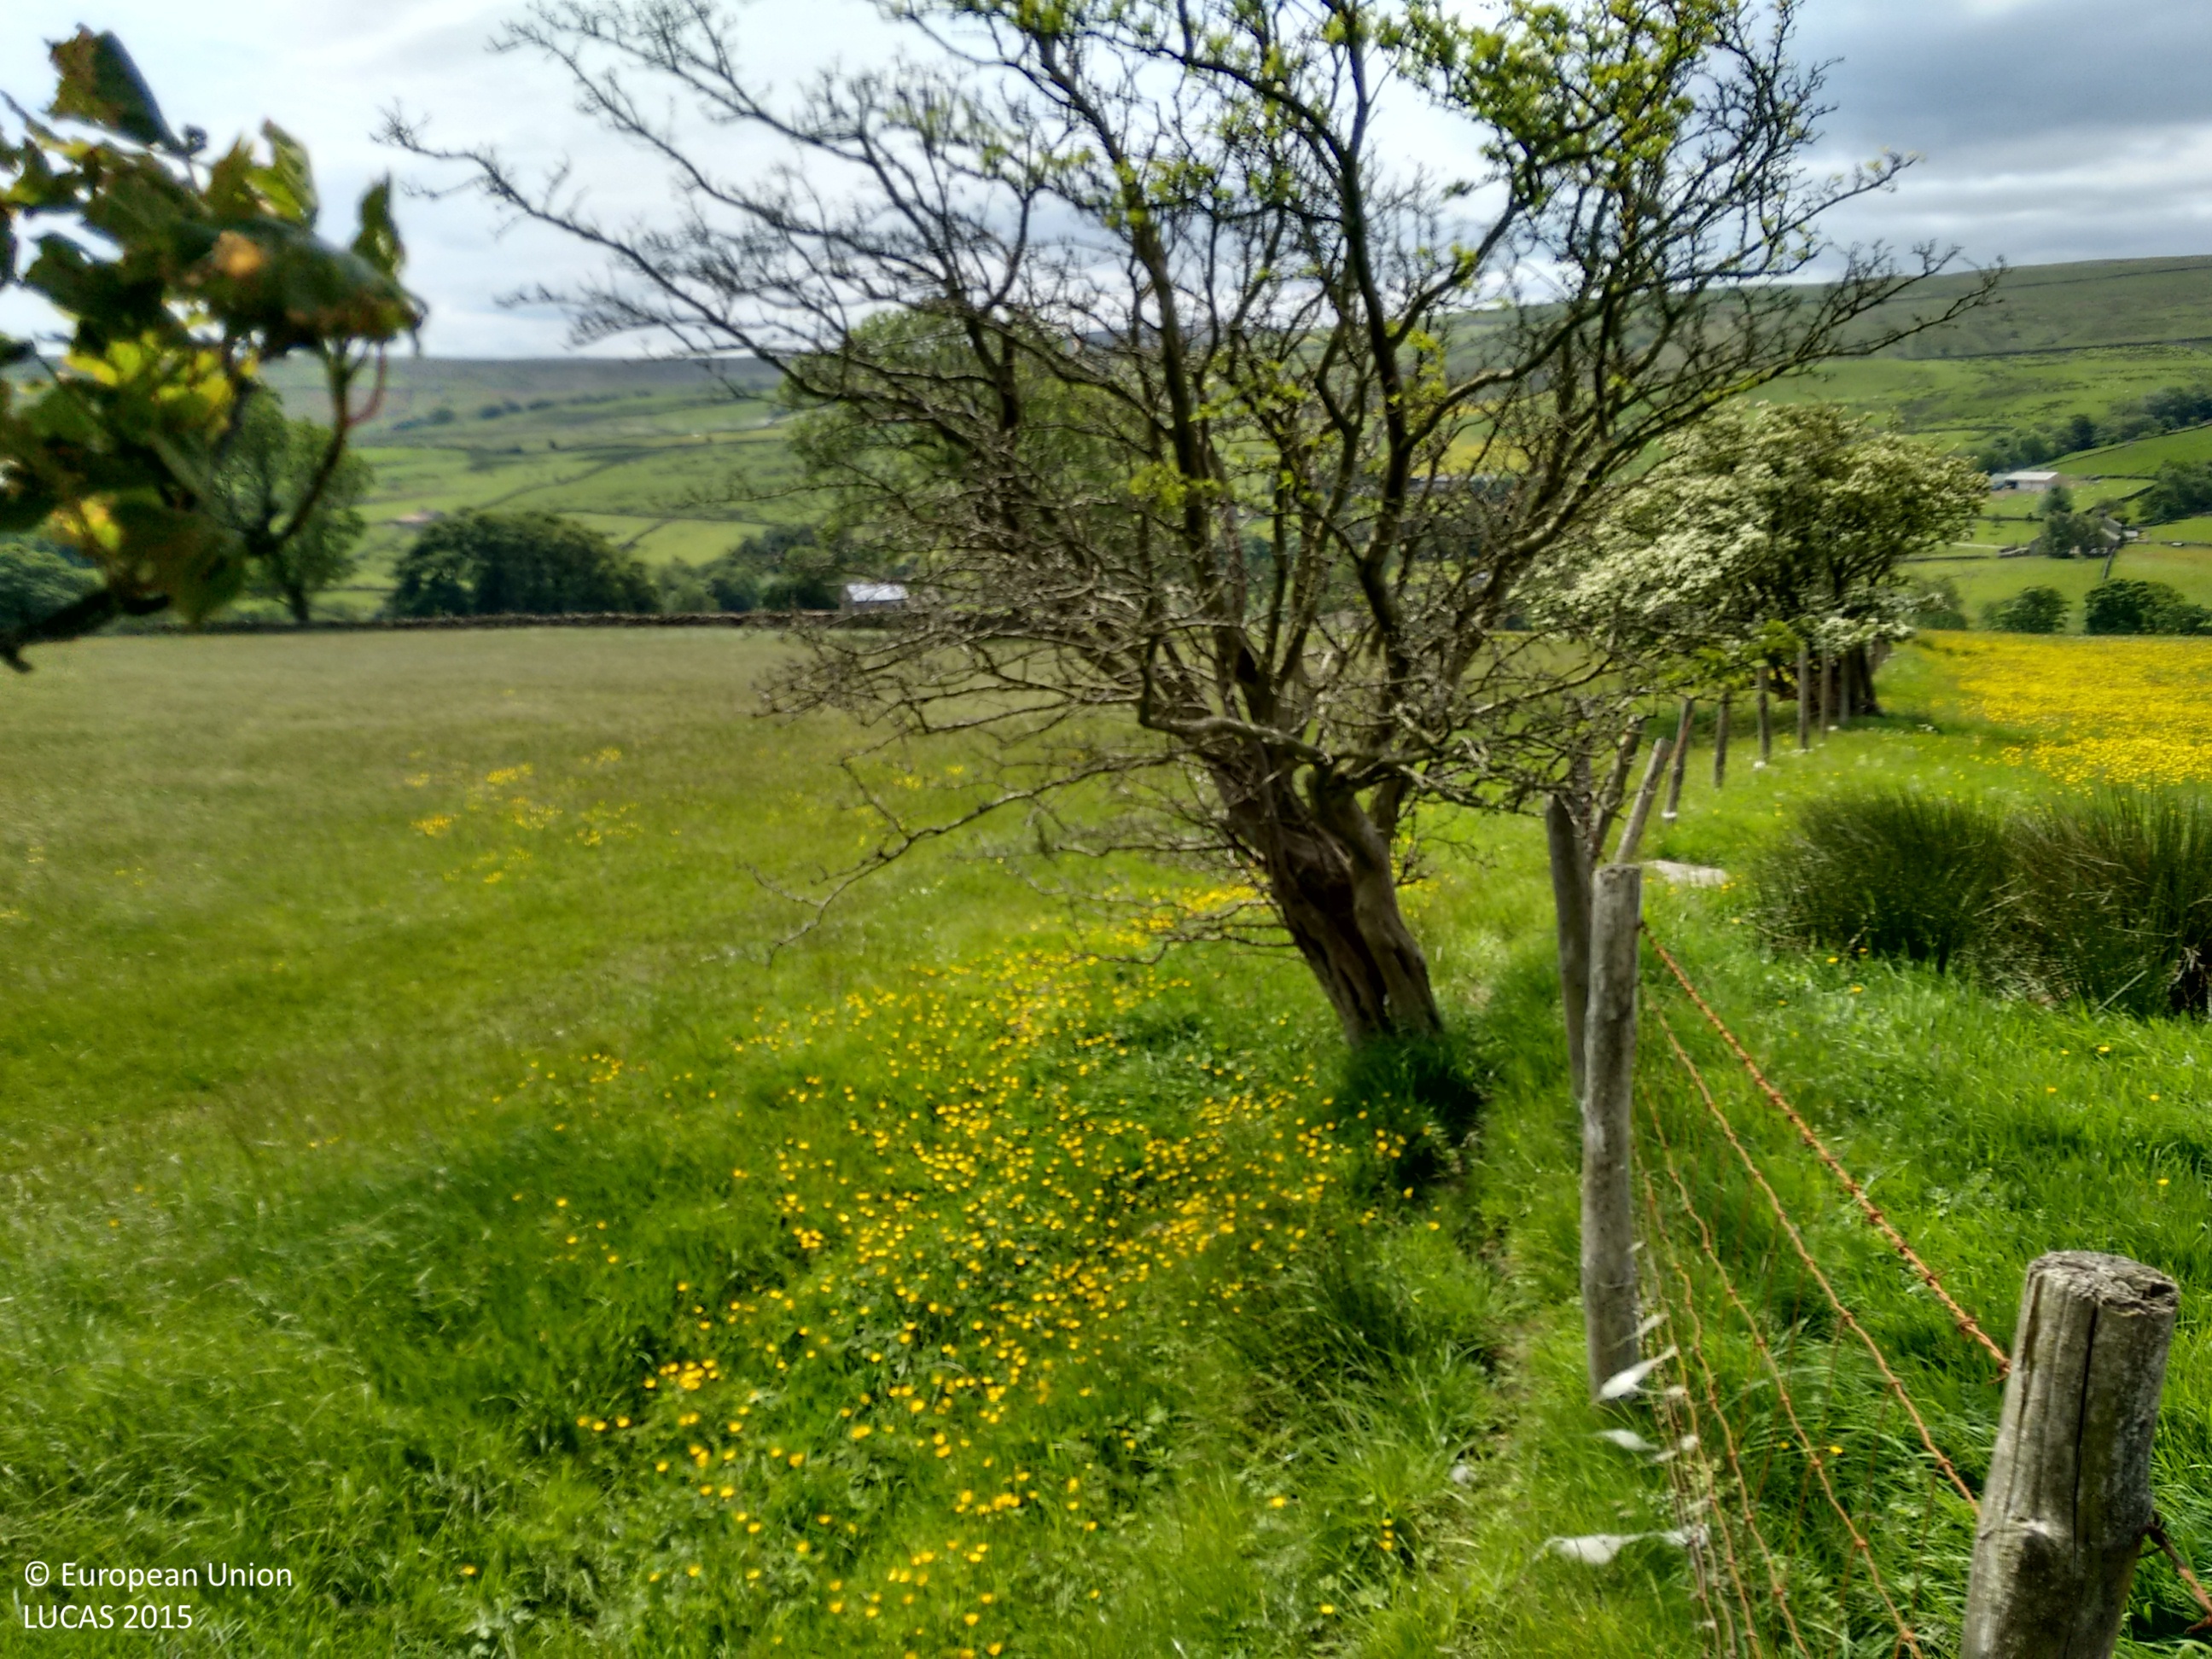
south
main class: Grassland
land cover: Grassland without tree/shrub cover
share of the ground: > 75 %
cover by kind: herbaceous plants 100 %
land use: Agriculture (excluding fallow land and kitchen gardens)
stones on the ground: < 10 %
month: June
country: GB
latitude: 54.1619
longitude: -1.8623
